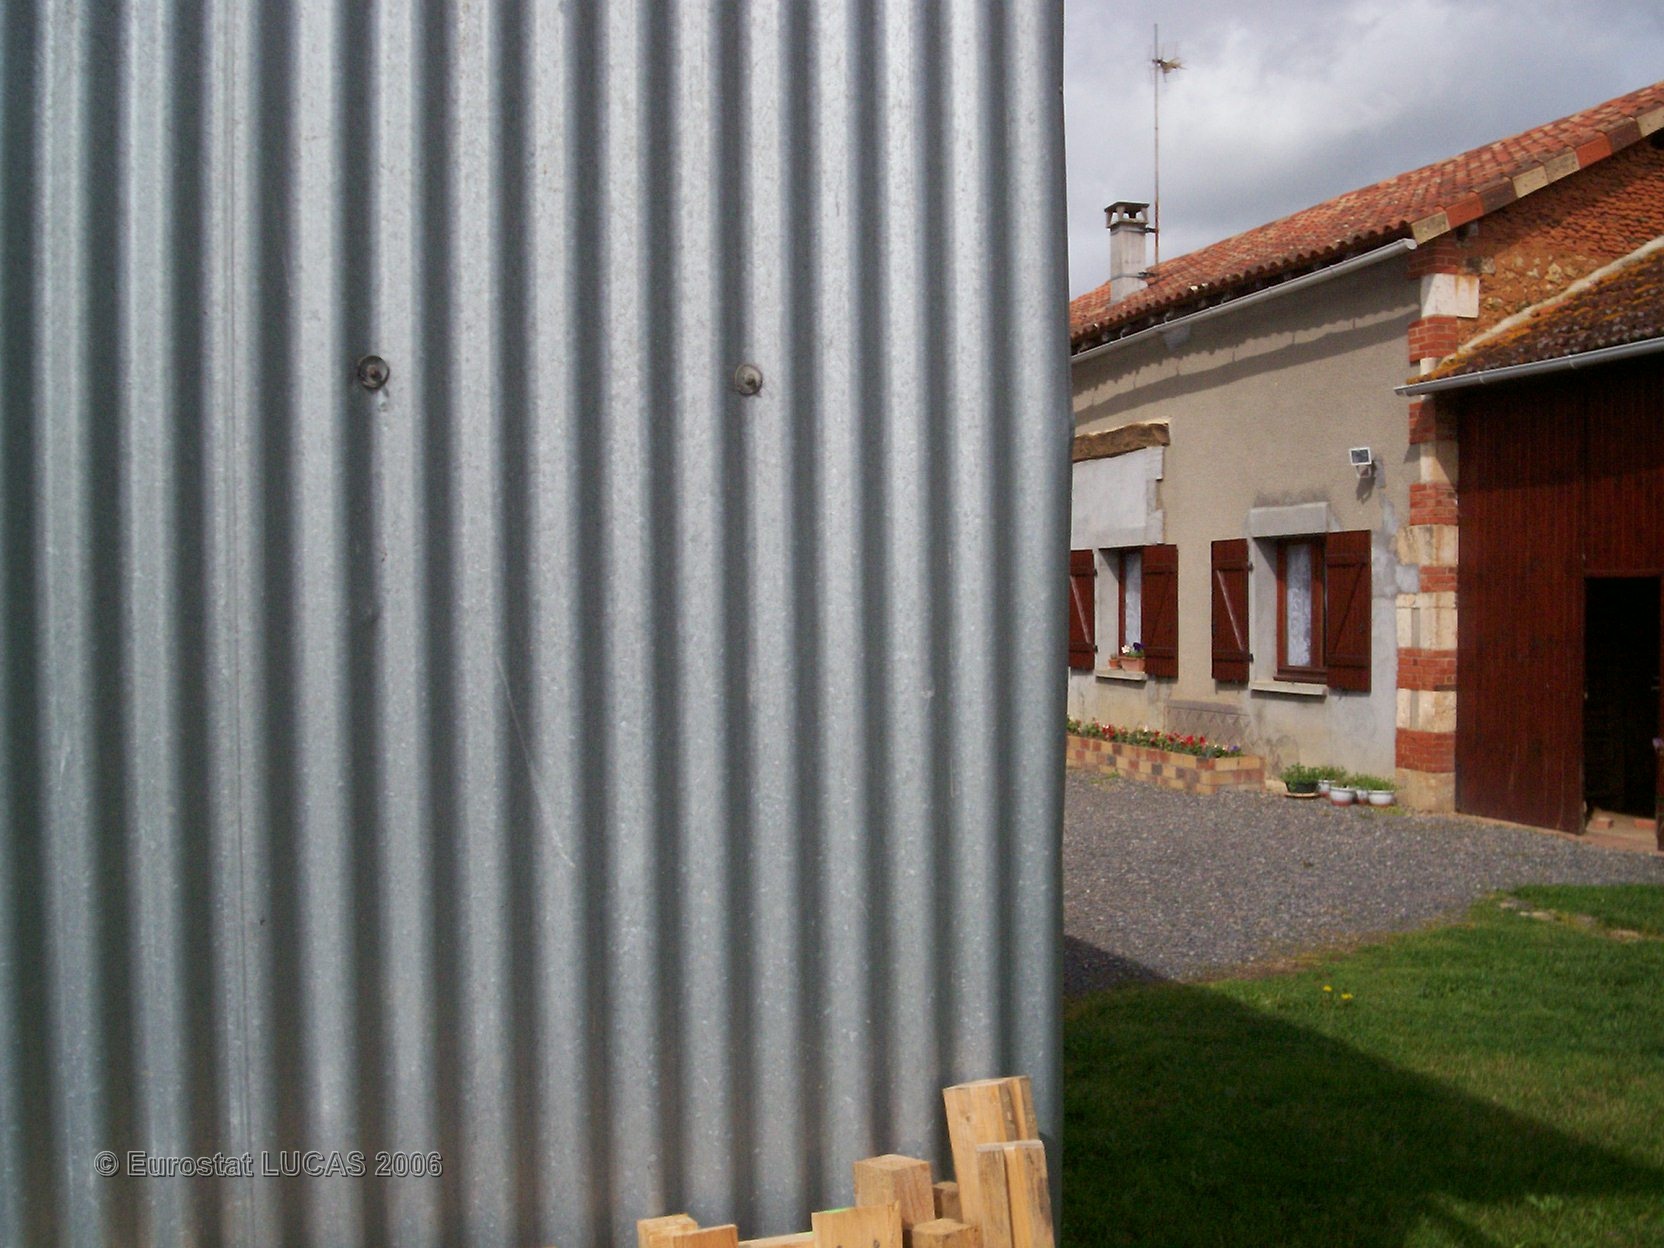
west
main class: Grassland
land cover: Grassland with sparse tree/shrub cover
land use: Residential
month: May
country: FR
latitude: 45.8924
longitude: 0.5130
